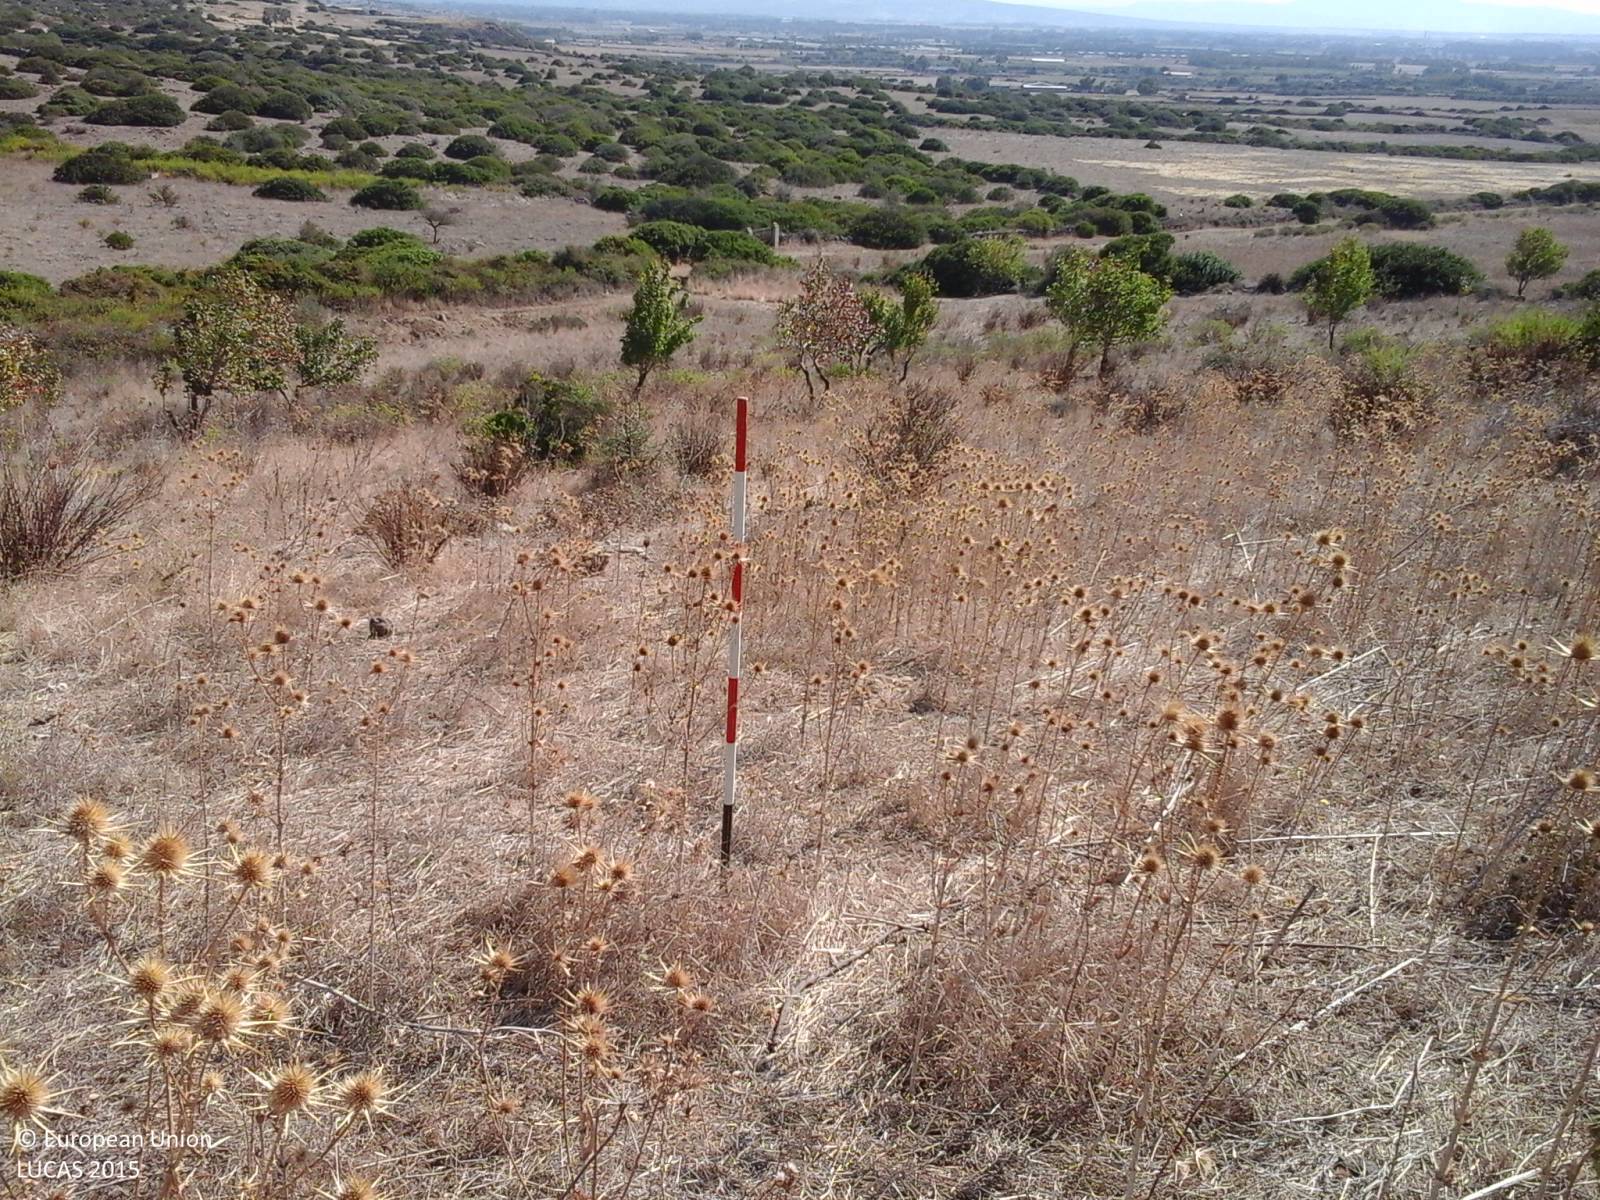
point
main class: Grassland
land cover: Grassland with sparse tree/shrub cover
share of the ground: > 75 %
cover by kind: herbaceous plants 90 %, broadleaved forest trees 5 %, shrubs 5 %
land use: Agriculture (excluding fallow land and kitchen gardens)
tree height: < 5 m
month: September
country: IT
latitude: 40.0392
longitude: 8.5429
